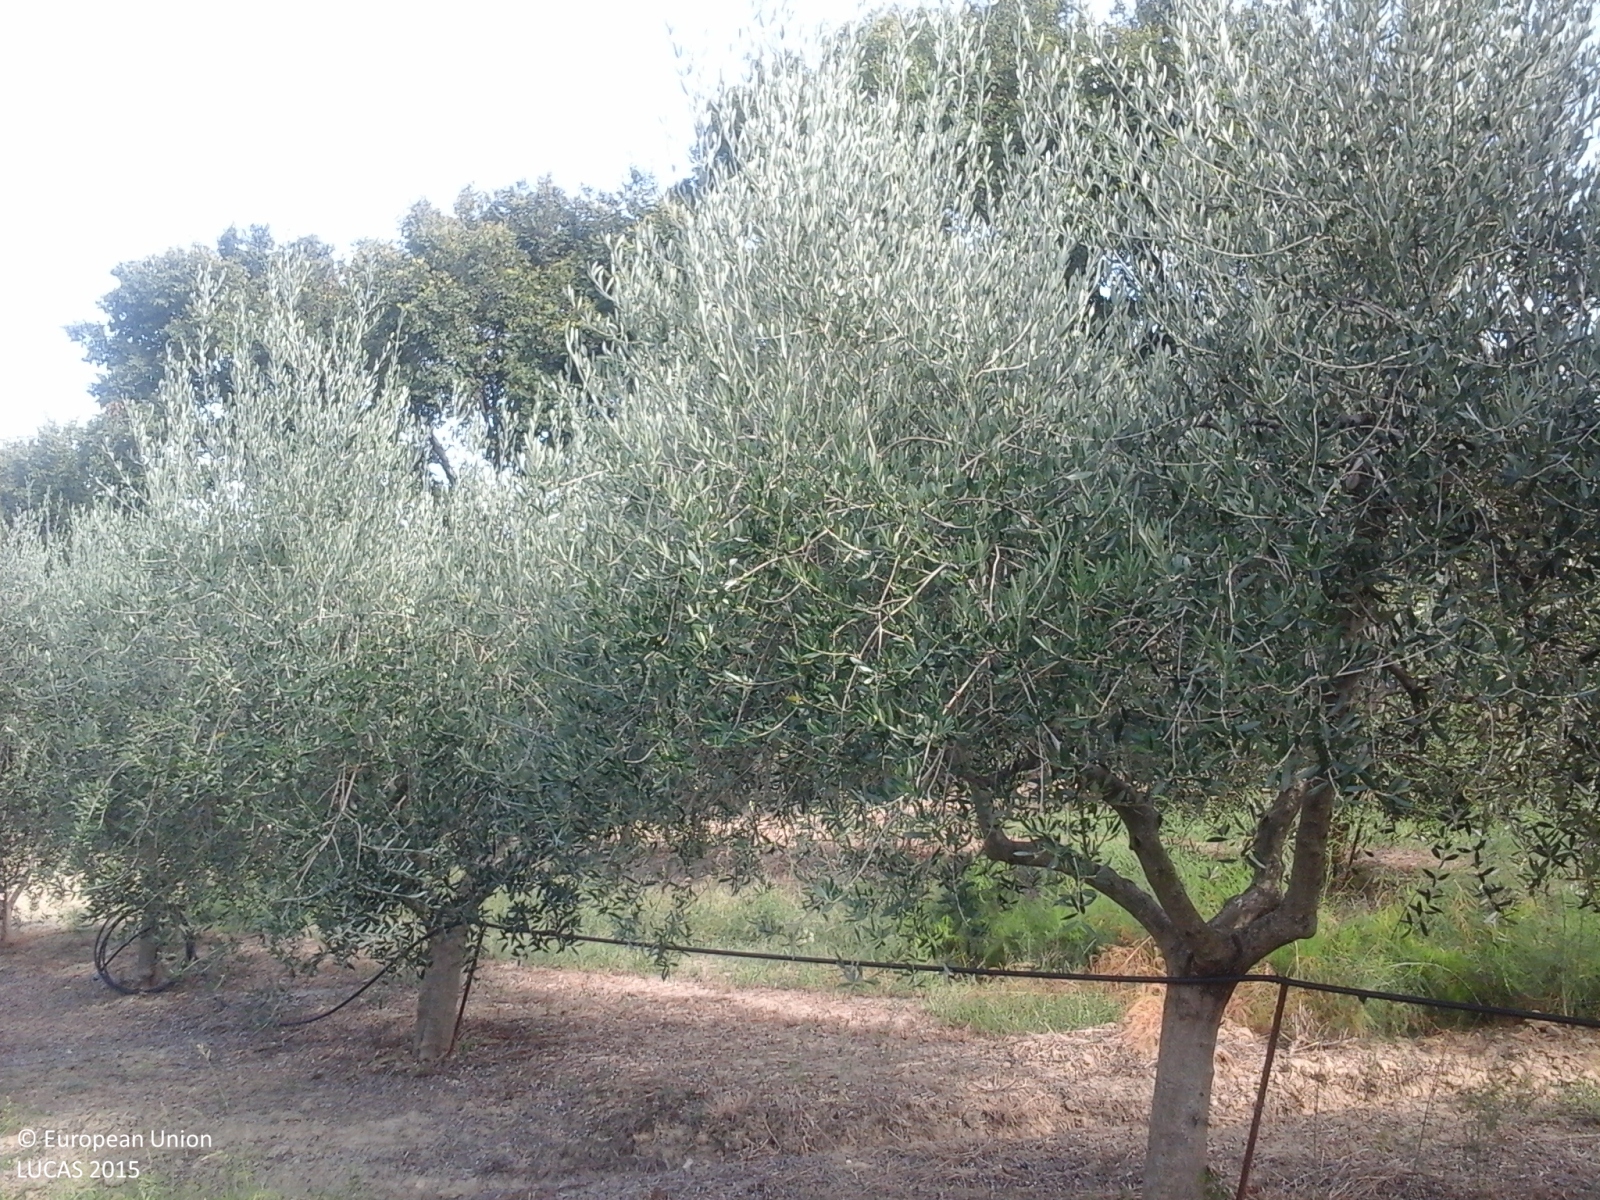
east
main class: Cropland
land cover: Olive groves
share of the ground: 50 - 75 %
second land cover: Grassland without tree/shrub cover
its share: > 75 %
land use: Agriculture (excluding fallow land and kitchen gardens)
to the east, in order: Olive groves; Grassland without tree/shrub cover; Lines of trees; Ditches and canals; Shrubland with sparse tree cover; Electric lines; Shrubland with sparse tree cover; Abandoned hedges; Durum wheat; Ditches and canals; Broadleaved woodland; Durum wheat
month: September
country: IT
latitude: 43.8056
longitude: 12.8646
